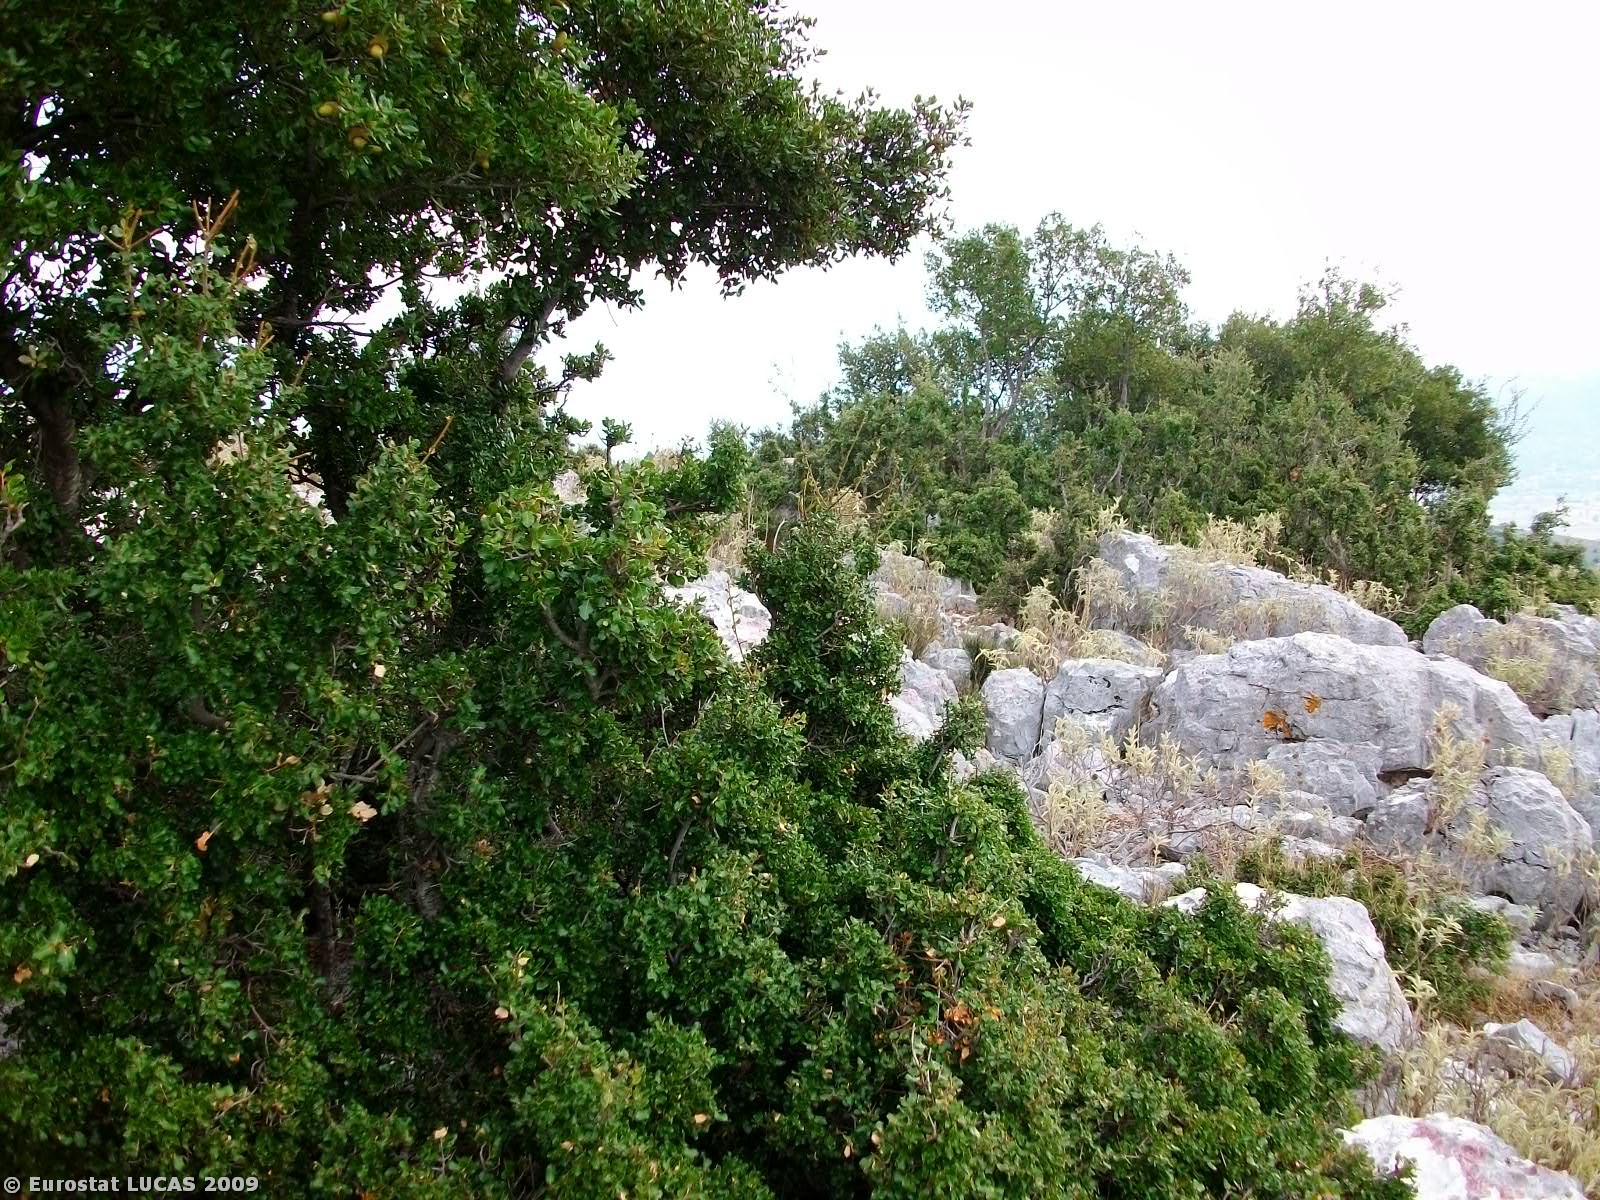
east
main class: Grassland
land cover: Grassland with sparse tree/shrub cover
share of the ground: > 75 %
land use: Unused
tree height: < 5 m
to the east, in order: Grassland with sparse tree/shrub cover; Shrubland without tree cover
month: October
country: GR
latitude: 39.4146
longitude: 20.4620
